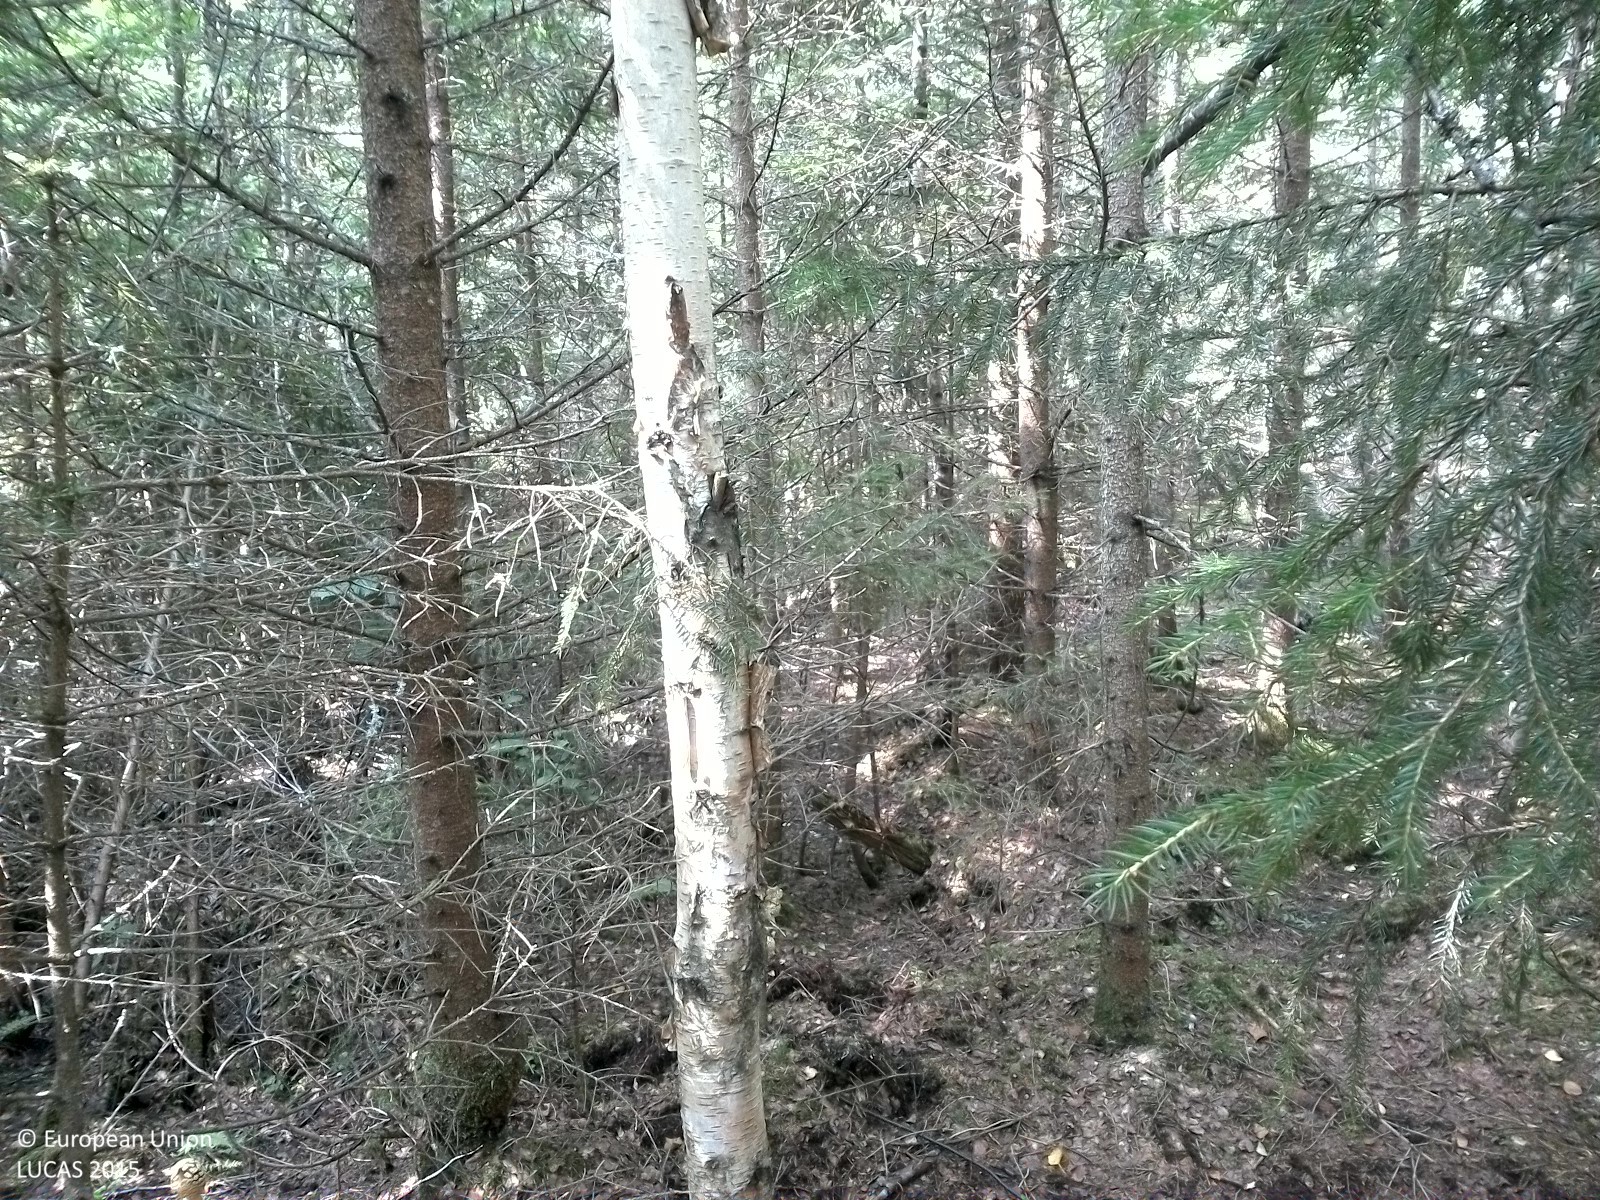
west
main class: Woodland
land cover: Spruce dominated mixed woodland
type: boreal forest
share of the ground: 50 - 75 %
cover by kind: coniferous forest trees 40 %, broadleaved forest trees 25 %, consolidated bare surface 20 %, lichens and mosses 10 %, herbaceous plants 5 %
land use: Forestry
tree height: < 5 m
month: August
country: SE
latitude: 59.0856
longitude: 15.3846
